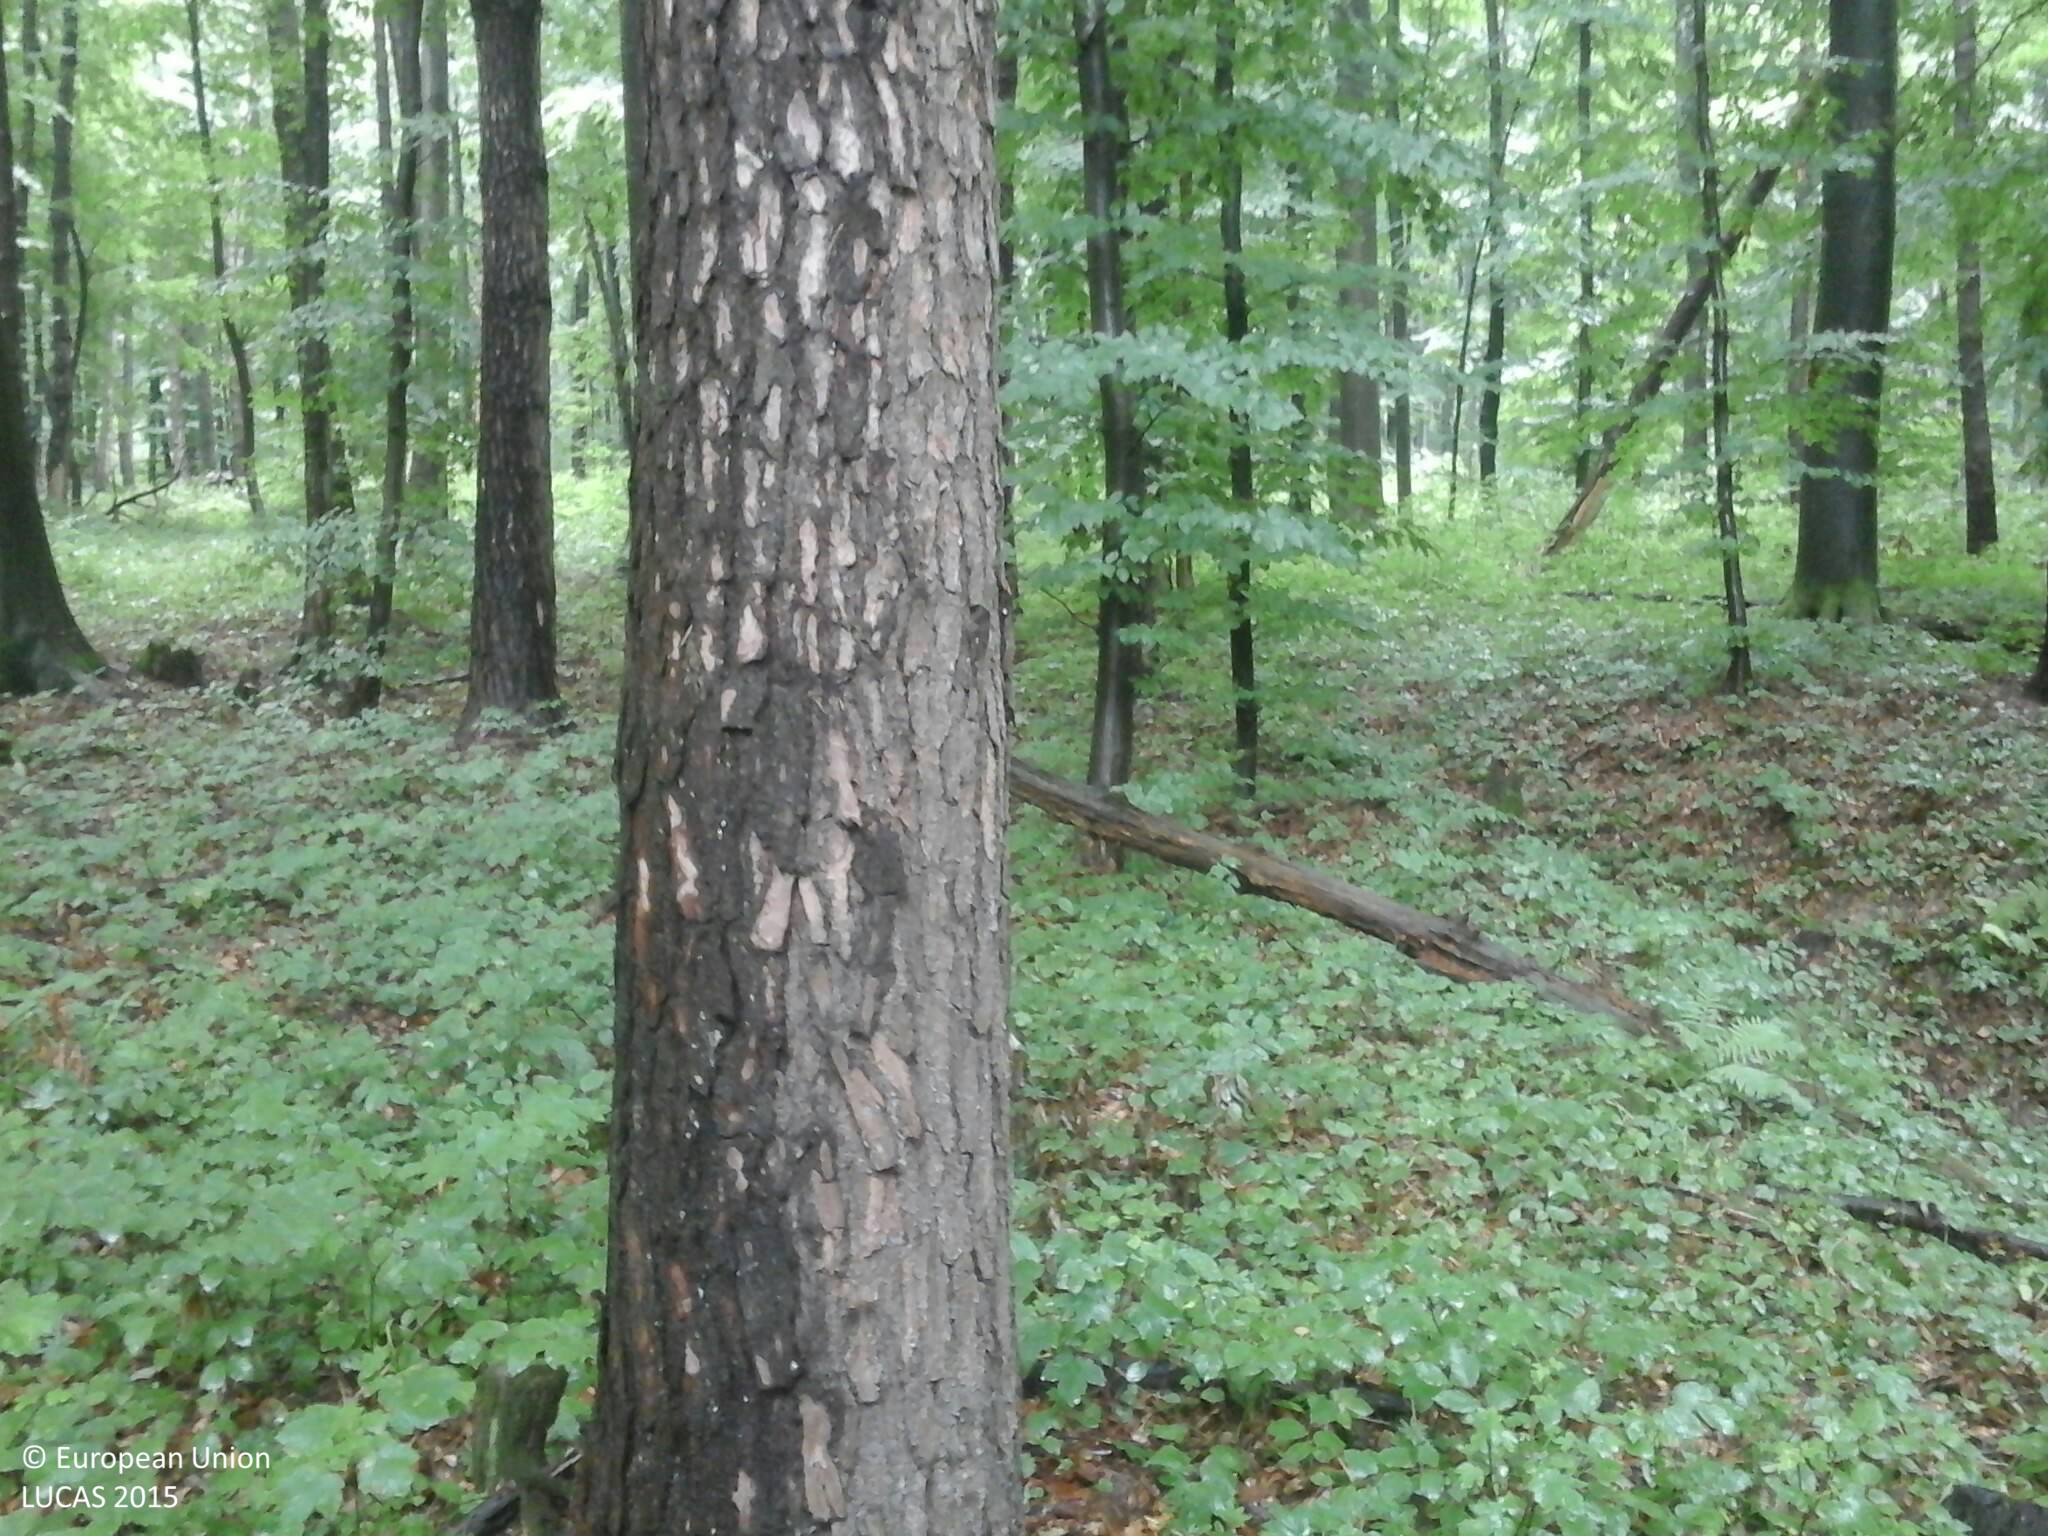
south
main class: Woodland
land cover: Broadleaved woodland
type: beech forest
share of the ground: > 75 %
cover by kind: broadleaved forest trees 80 %, shrubs 10 %, herbaceous plants 10 %
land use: Forestry
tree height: > 5 m
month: July
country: HU
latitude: 46.5862
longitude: 16.5138
